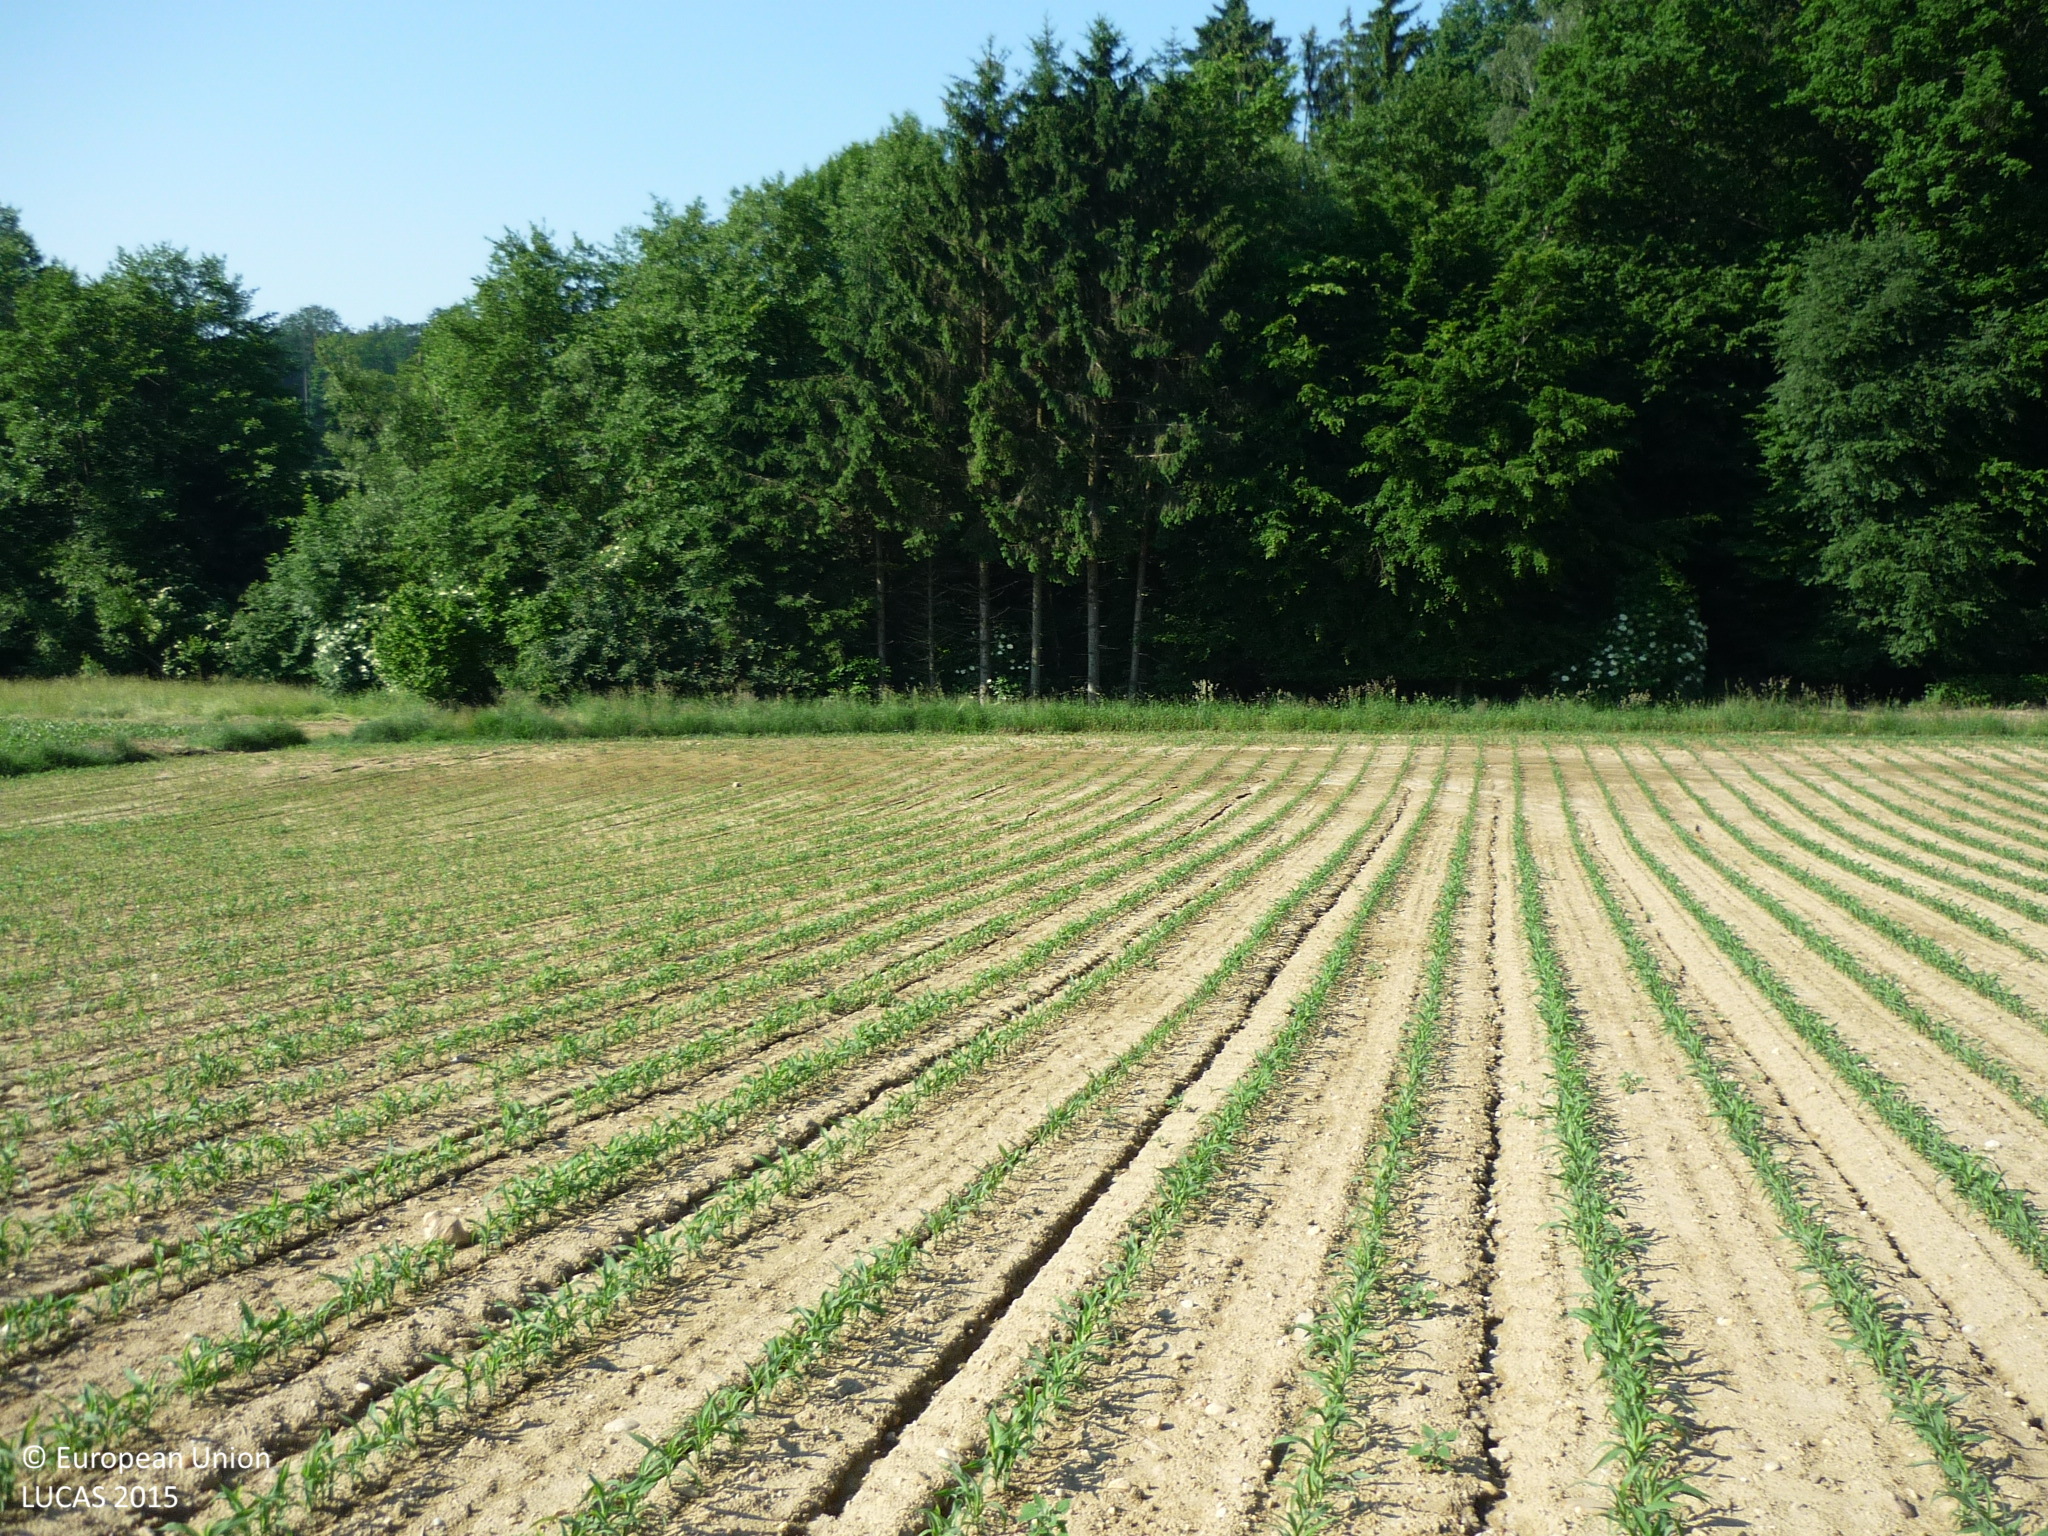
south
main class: Cropland
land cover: Maize
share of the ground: 25 - 50 %
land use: Agriculture (excluding fallow land and kitchen gardens)
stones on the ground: 10 - 25 %
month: June
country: AT
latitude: 46.8130
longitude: 15.7007
